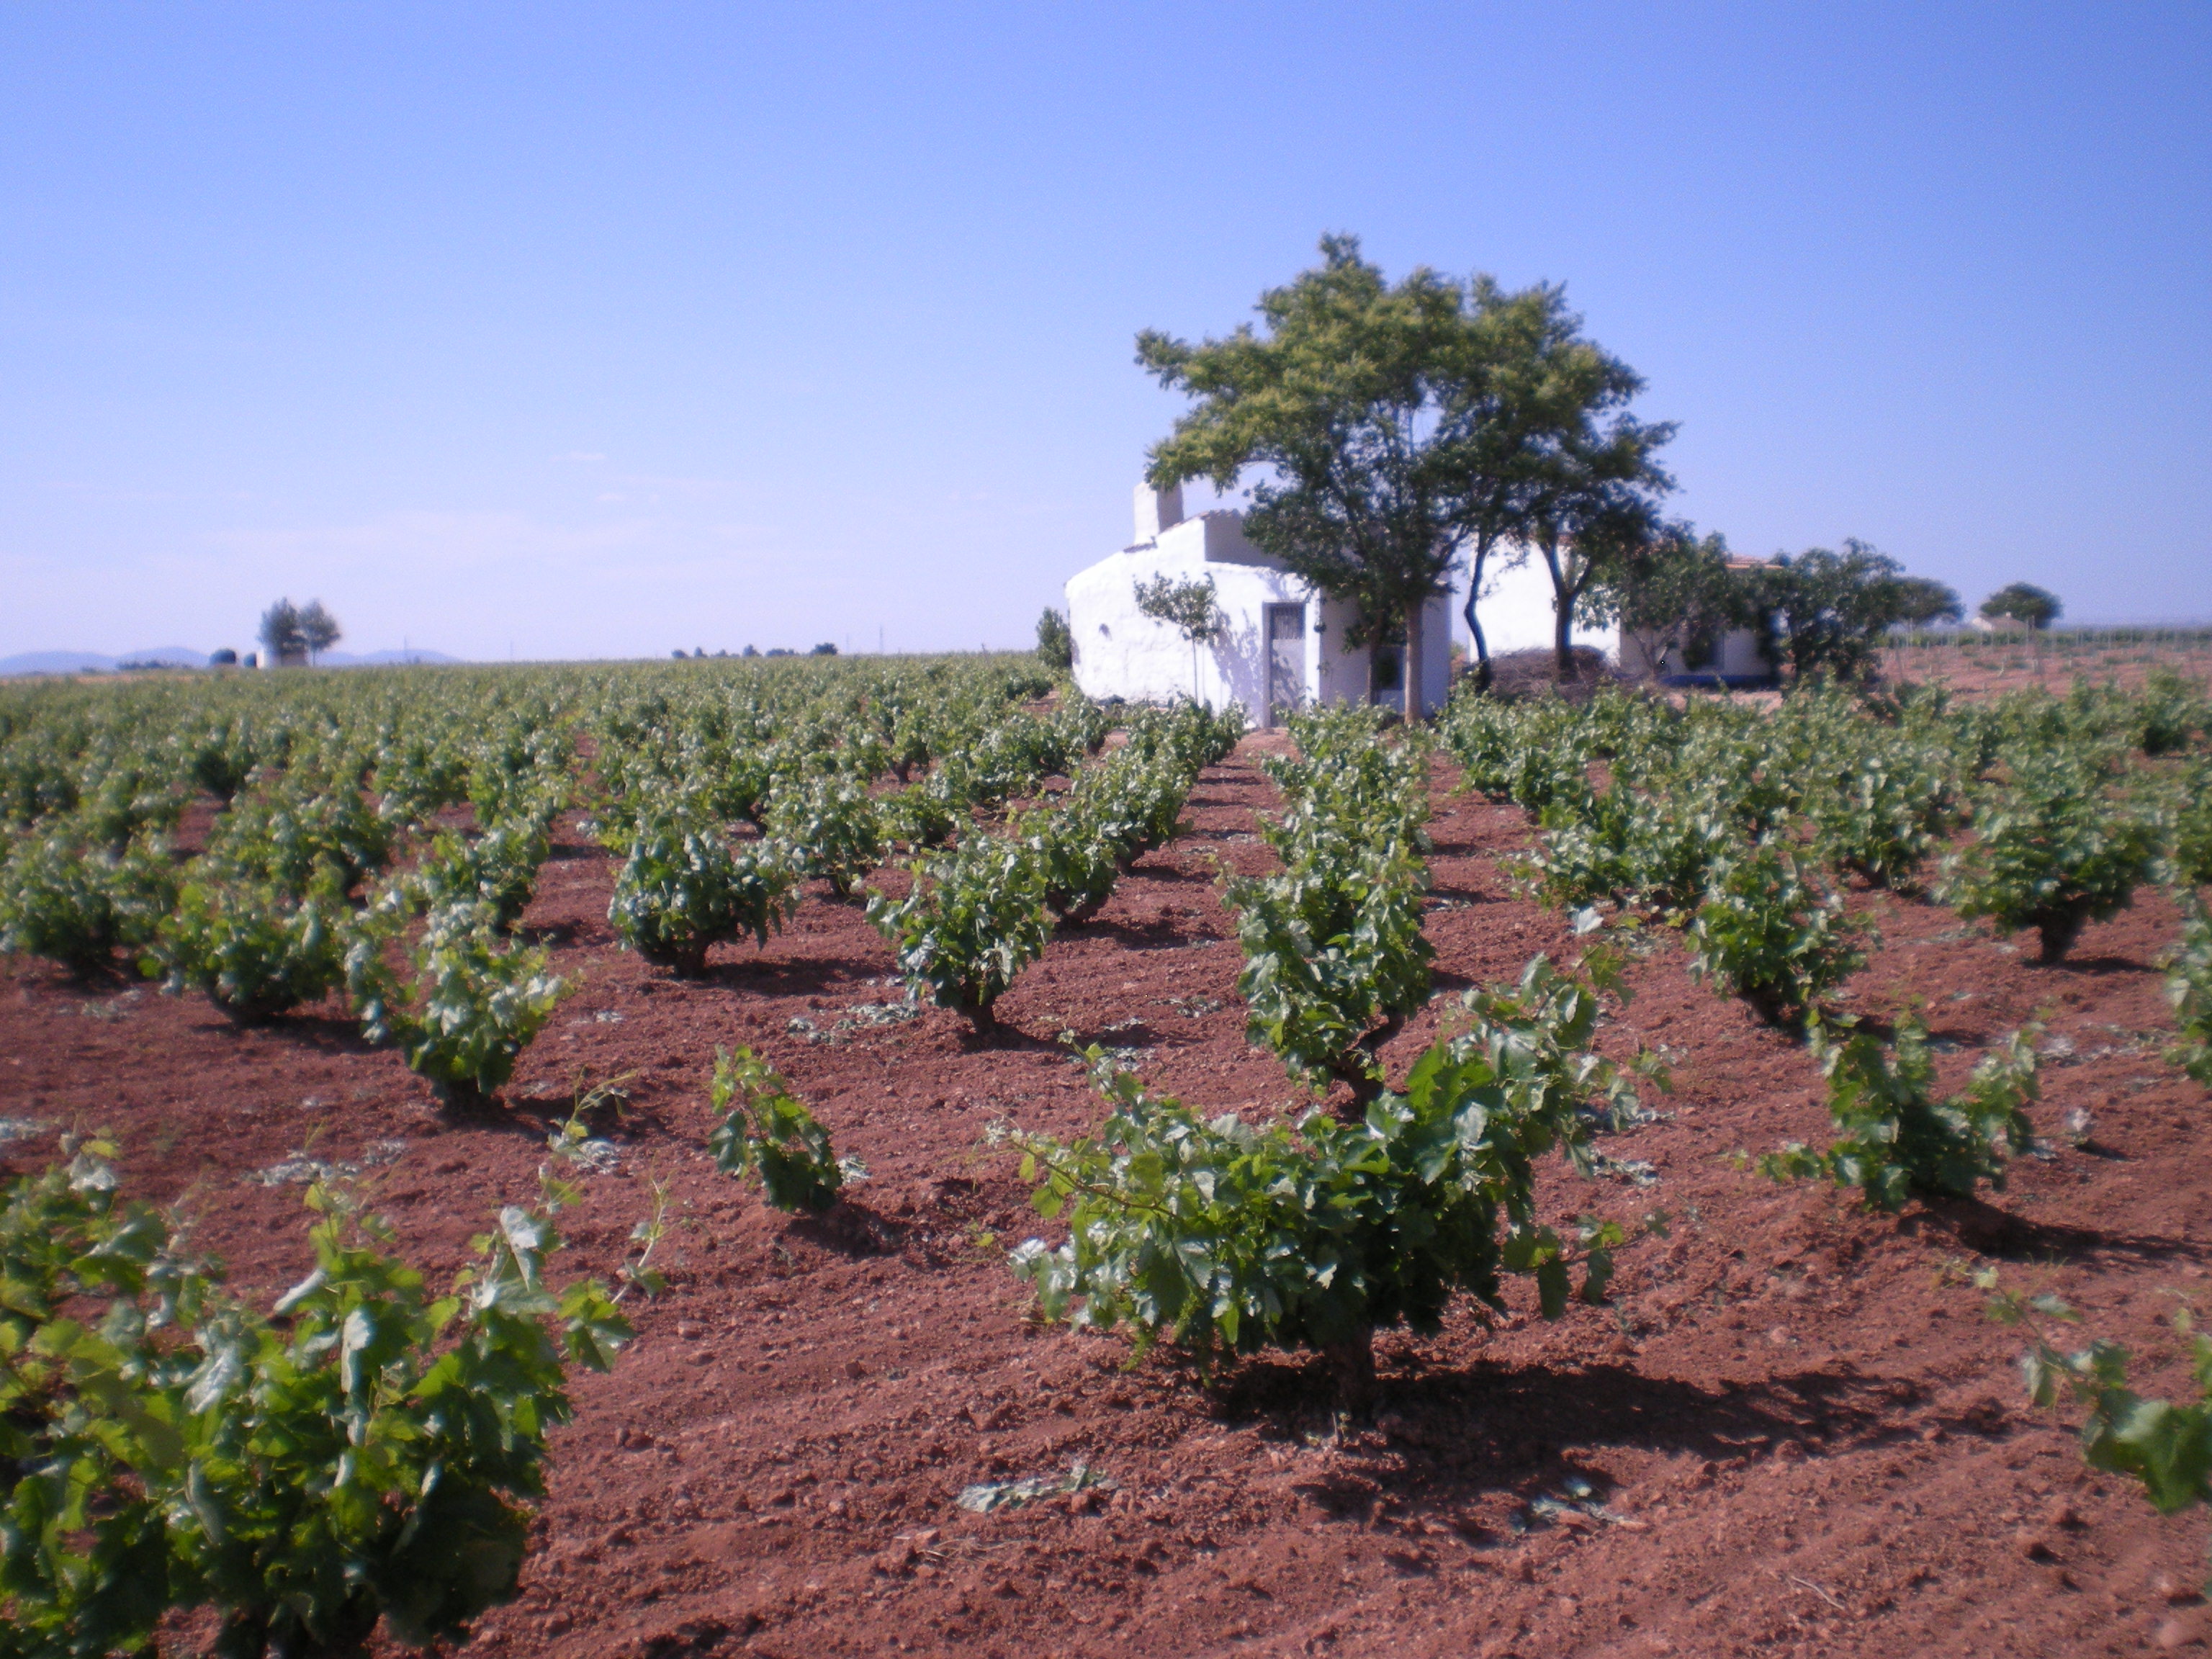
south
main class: Cropland
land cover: Vineyards
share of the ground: 10 - 25 %
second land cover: Other bare soil
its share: > 75 %
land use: Agriculture (excluding fallow land and kitchen gardens)
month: May
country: ES
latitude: 39.0462
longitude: -3.4300
